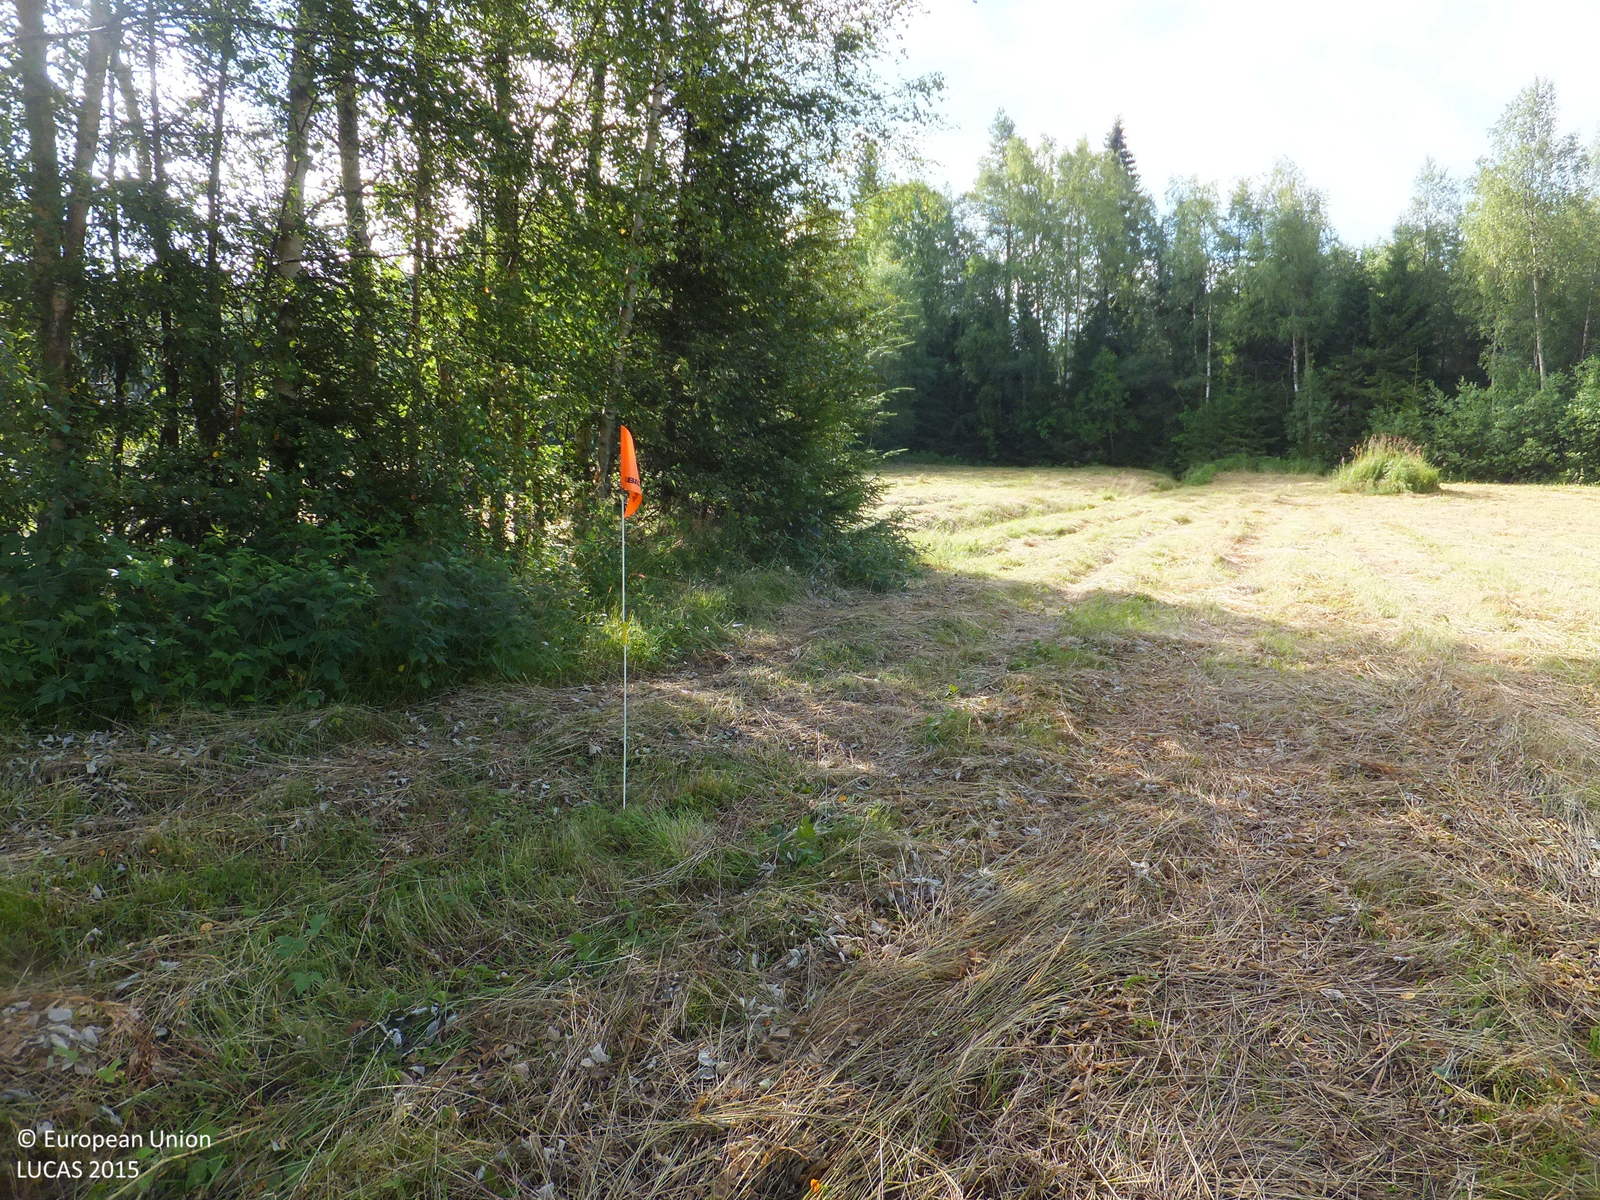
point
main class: Grassland
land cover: Grassland without tree/shrub cover
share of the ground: > 75 %
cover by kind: herbaceous plants 100 %
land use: Agriculture (excluding fallow land and kitchen gardens)
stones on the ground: < 10 %
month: July
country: FI
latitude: 63.1422
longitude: 21.6866
